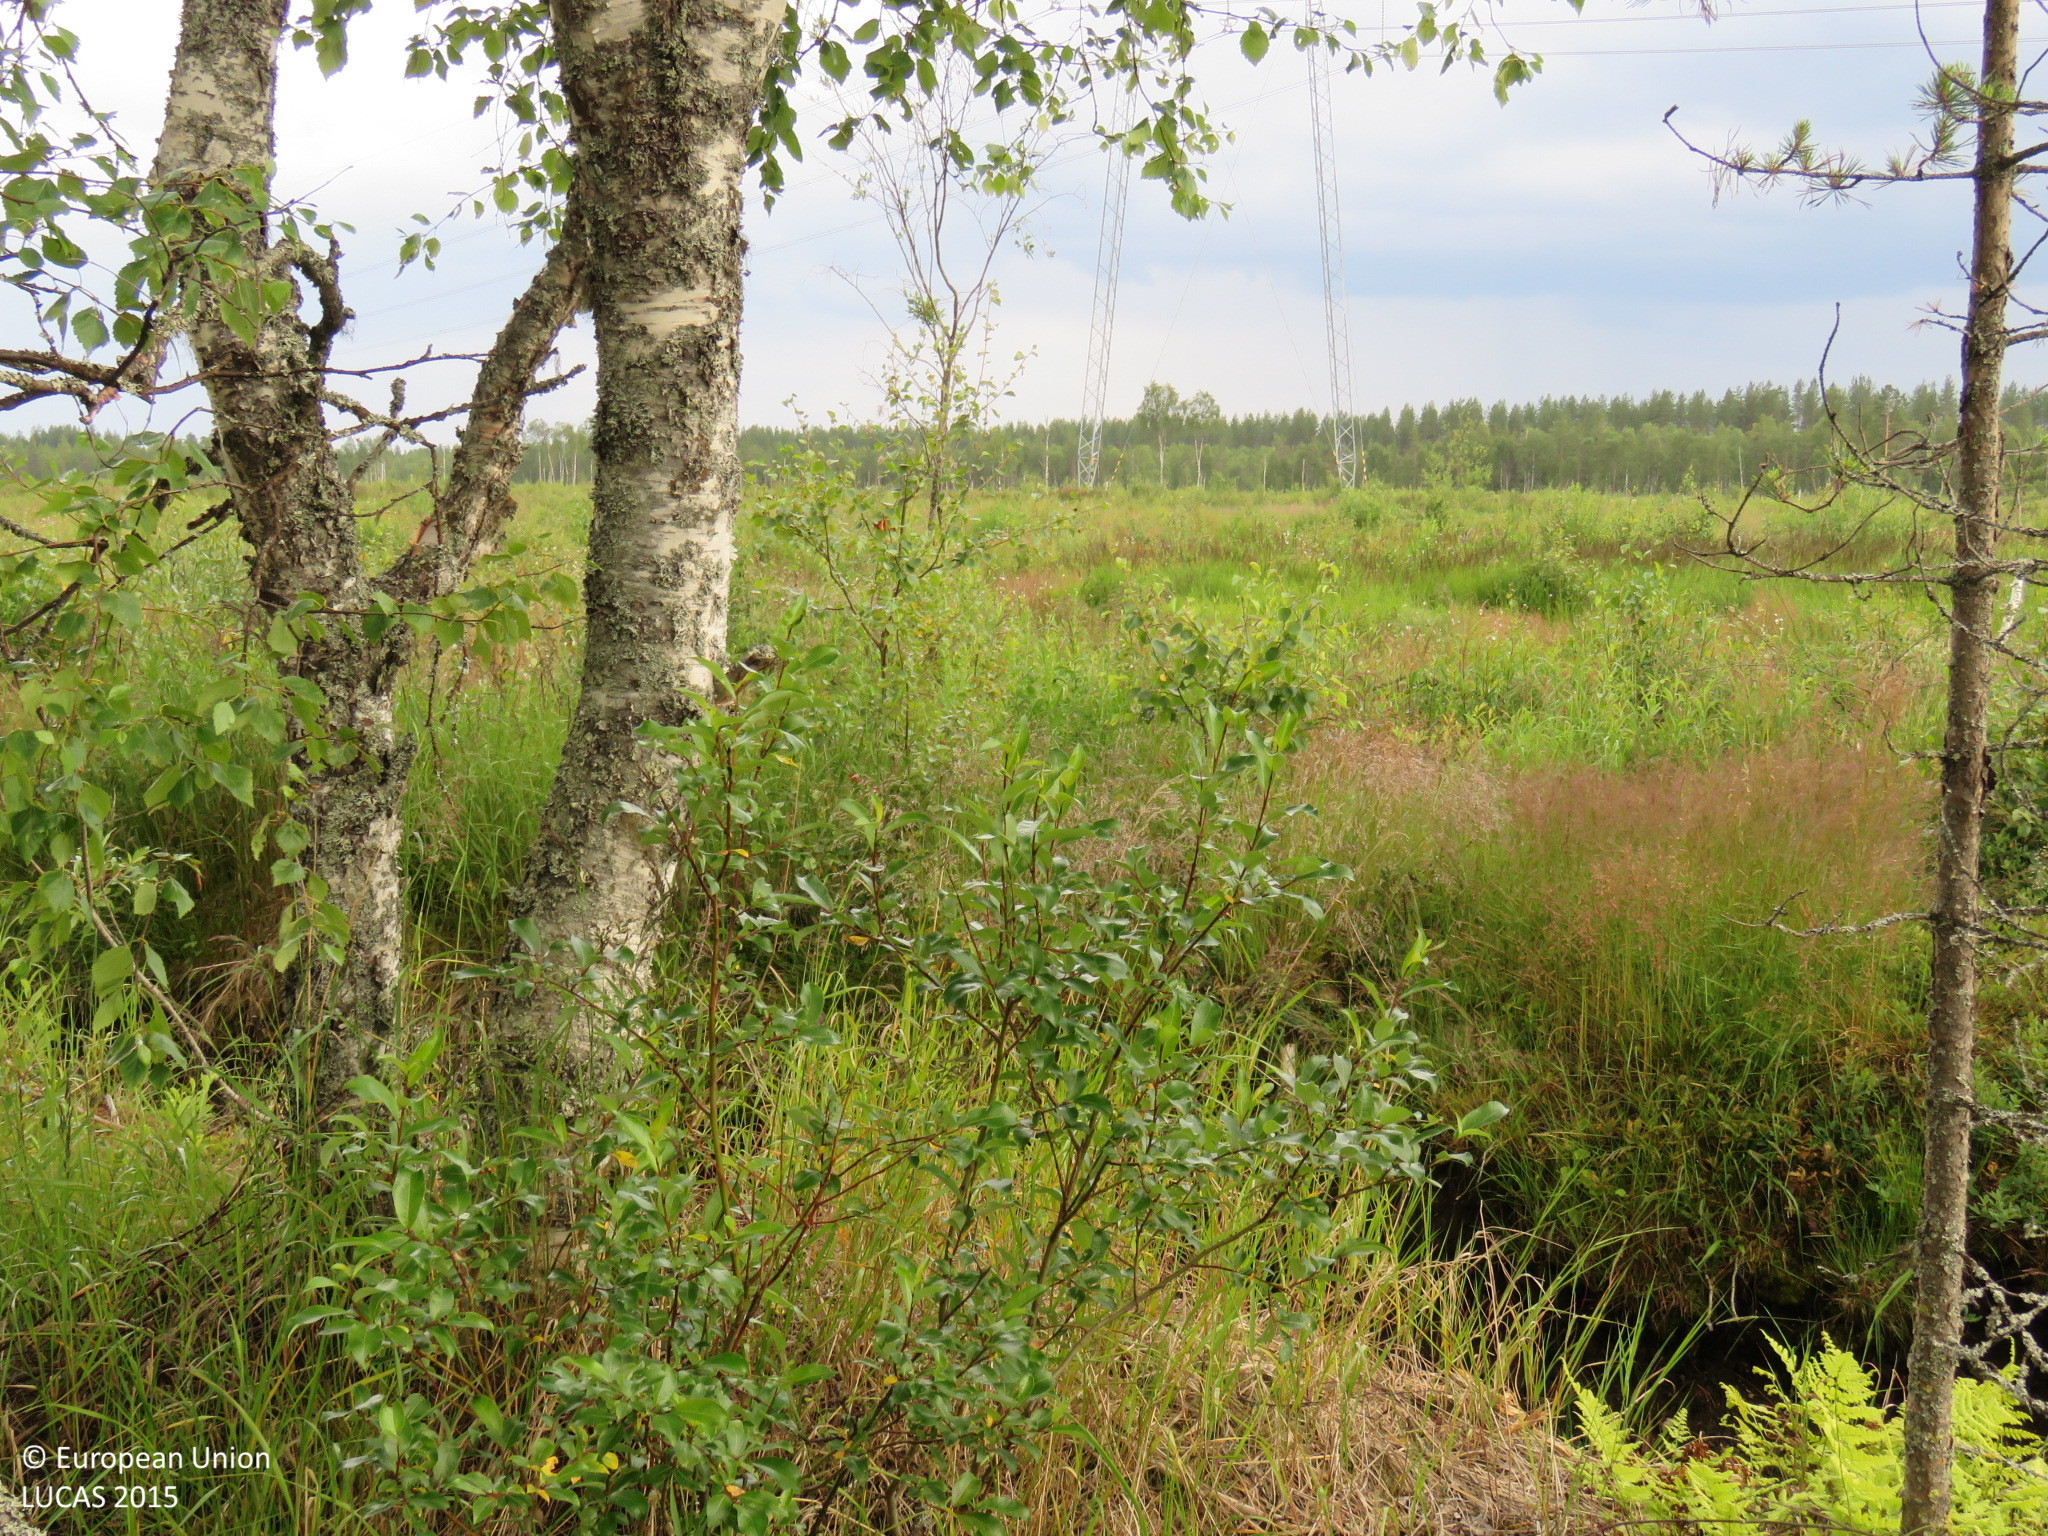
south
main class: Woodland
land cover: Pine dominated mixed woodland
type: mire and swamp forests
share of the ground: 50 - 75 %
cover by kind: coniferous forest trees 35 %, broadleaved forest trees 35 %, lichens and mosses 20 %, herbaceous plants 10 %
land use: Forestry
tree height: > 5 m
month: July
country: FI
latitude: 64.5294
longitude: 26.4736
